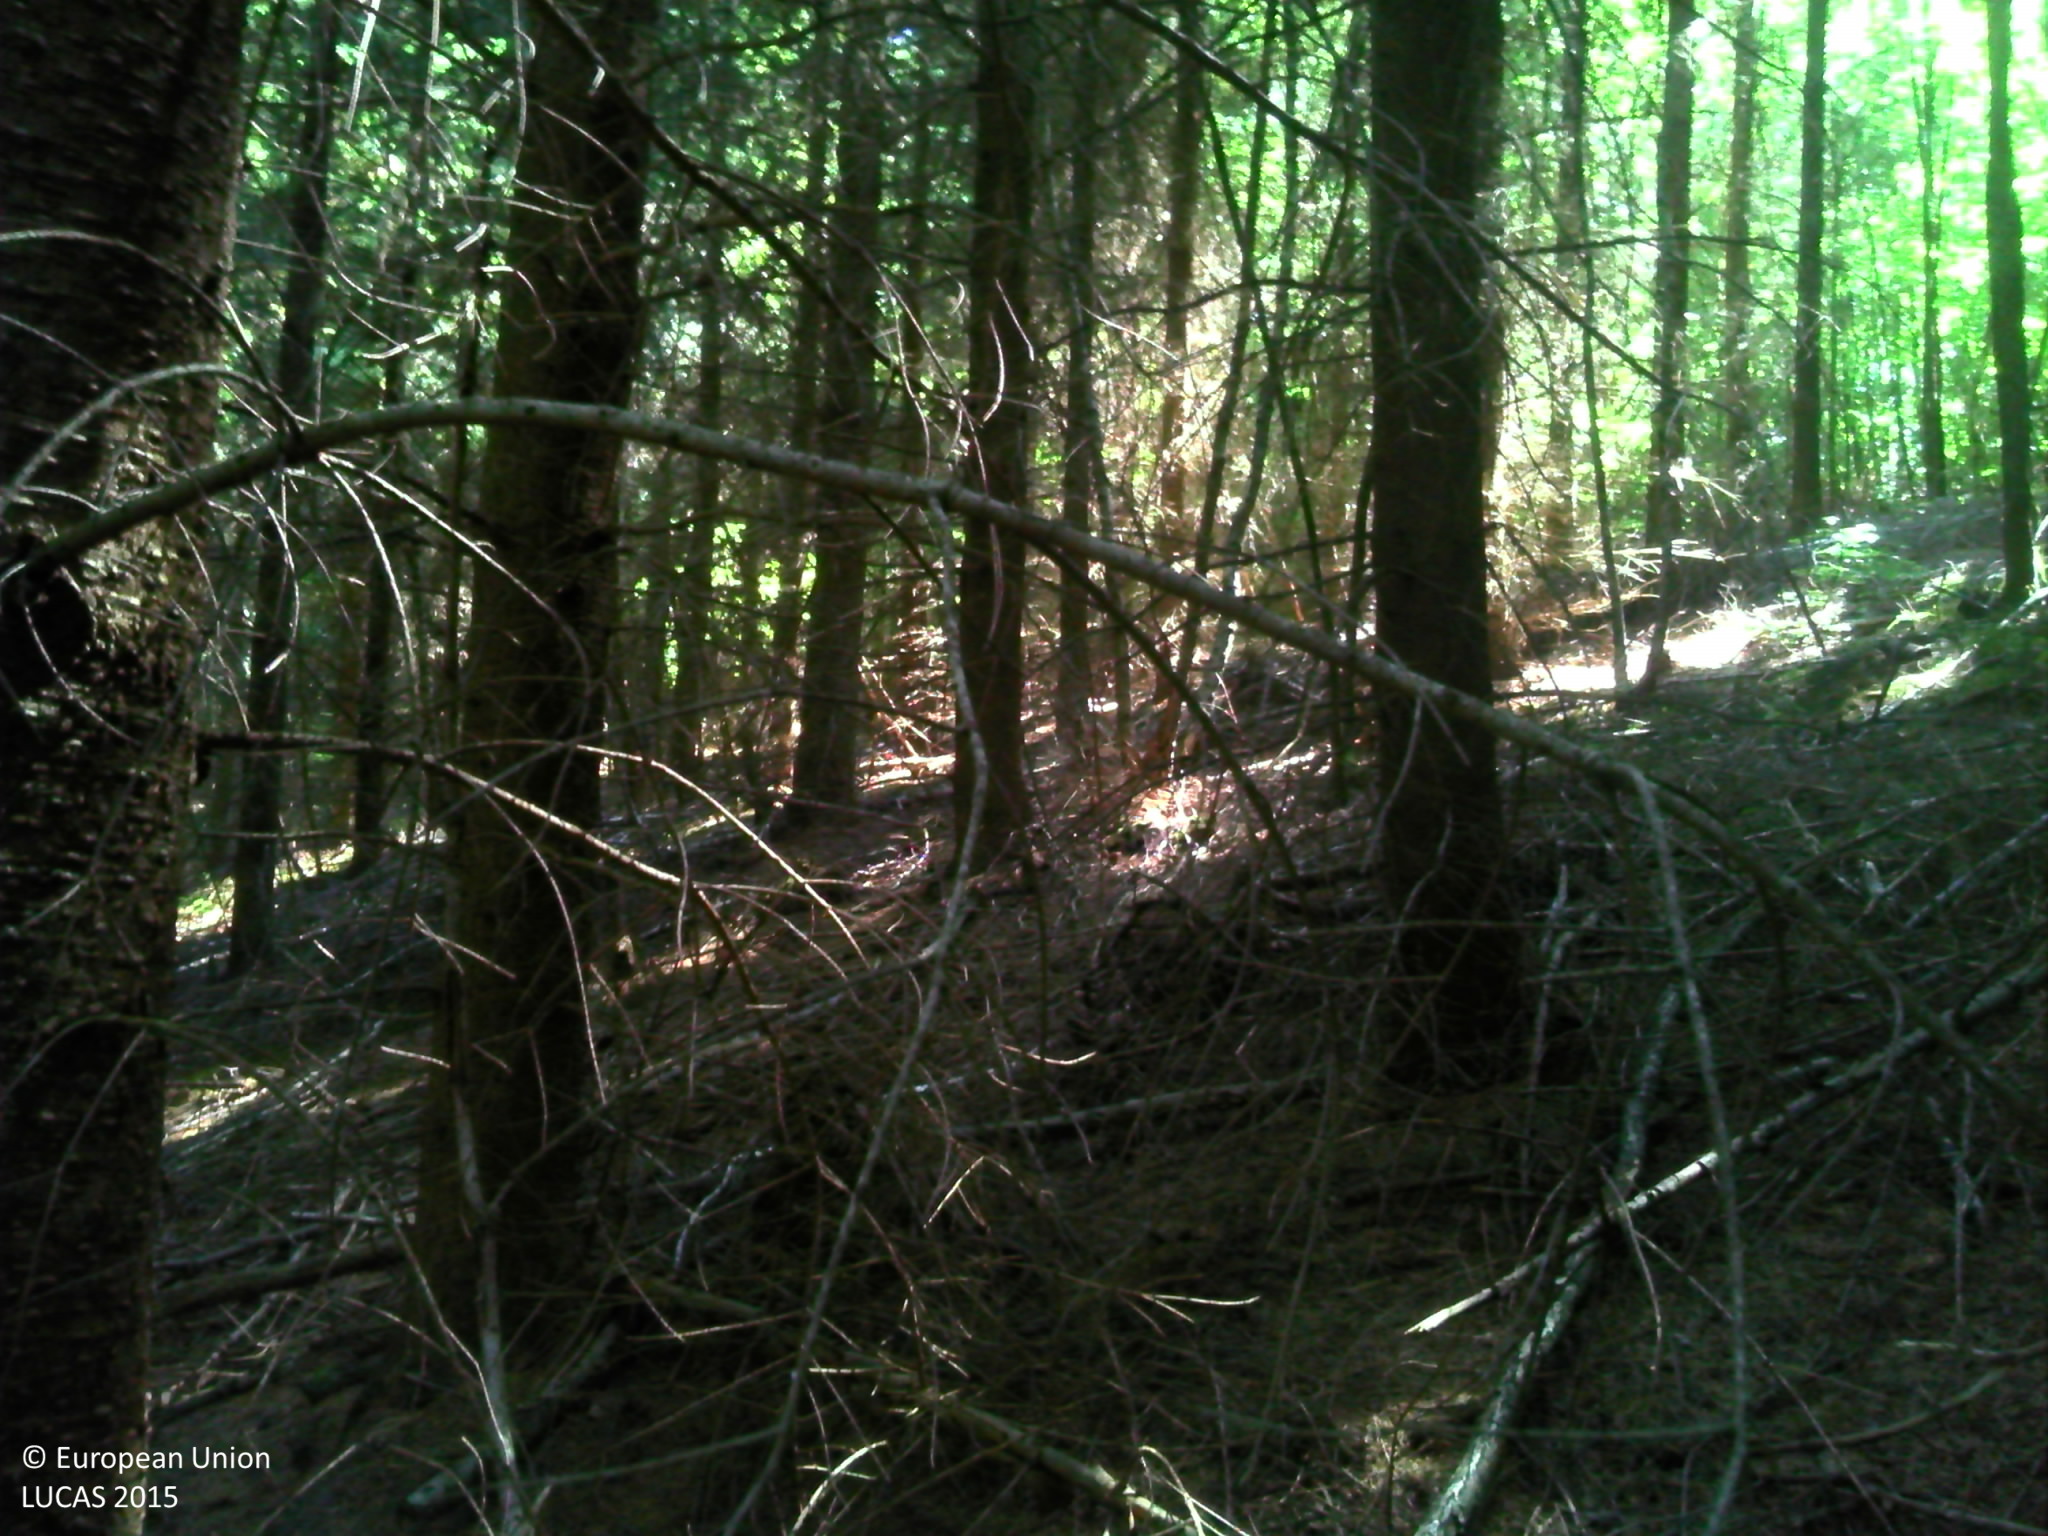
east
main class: Woodland
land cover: Spruce dominated coniferous woodland
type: hemiboreal forest and nemoral coniferous forest and mixed broadleaved-coniferous forest
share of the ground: > 75 %
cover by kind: coniferous forest trees 80 %, herbaceous plants 20 %
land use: Forestry
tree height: > 5 m
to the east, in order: Spruce dominated coniferous woodland; Spruce dominated mixed woodland; Spruce dominated coniferous woodland; Spruce dominated mixed woodland; Tracks; Spruce dominated mixed woodland
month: August
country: FR
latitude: 45.7078
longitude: 4.5699
